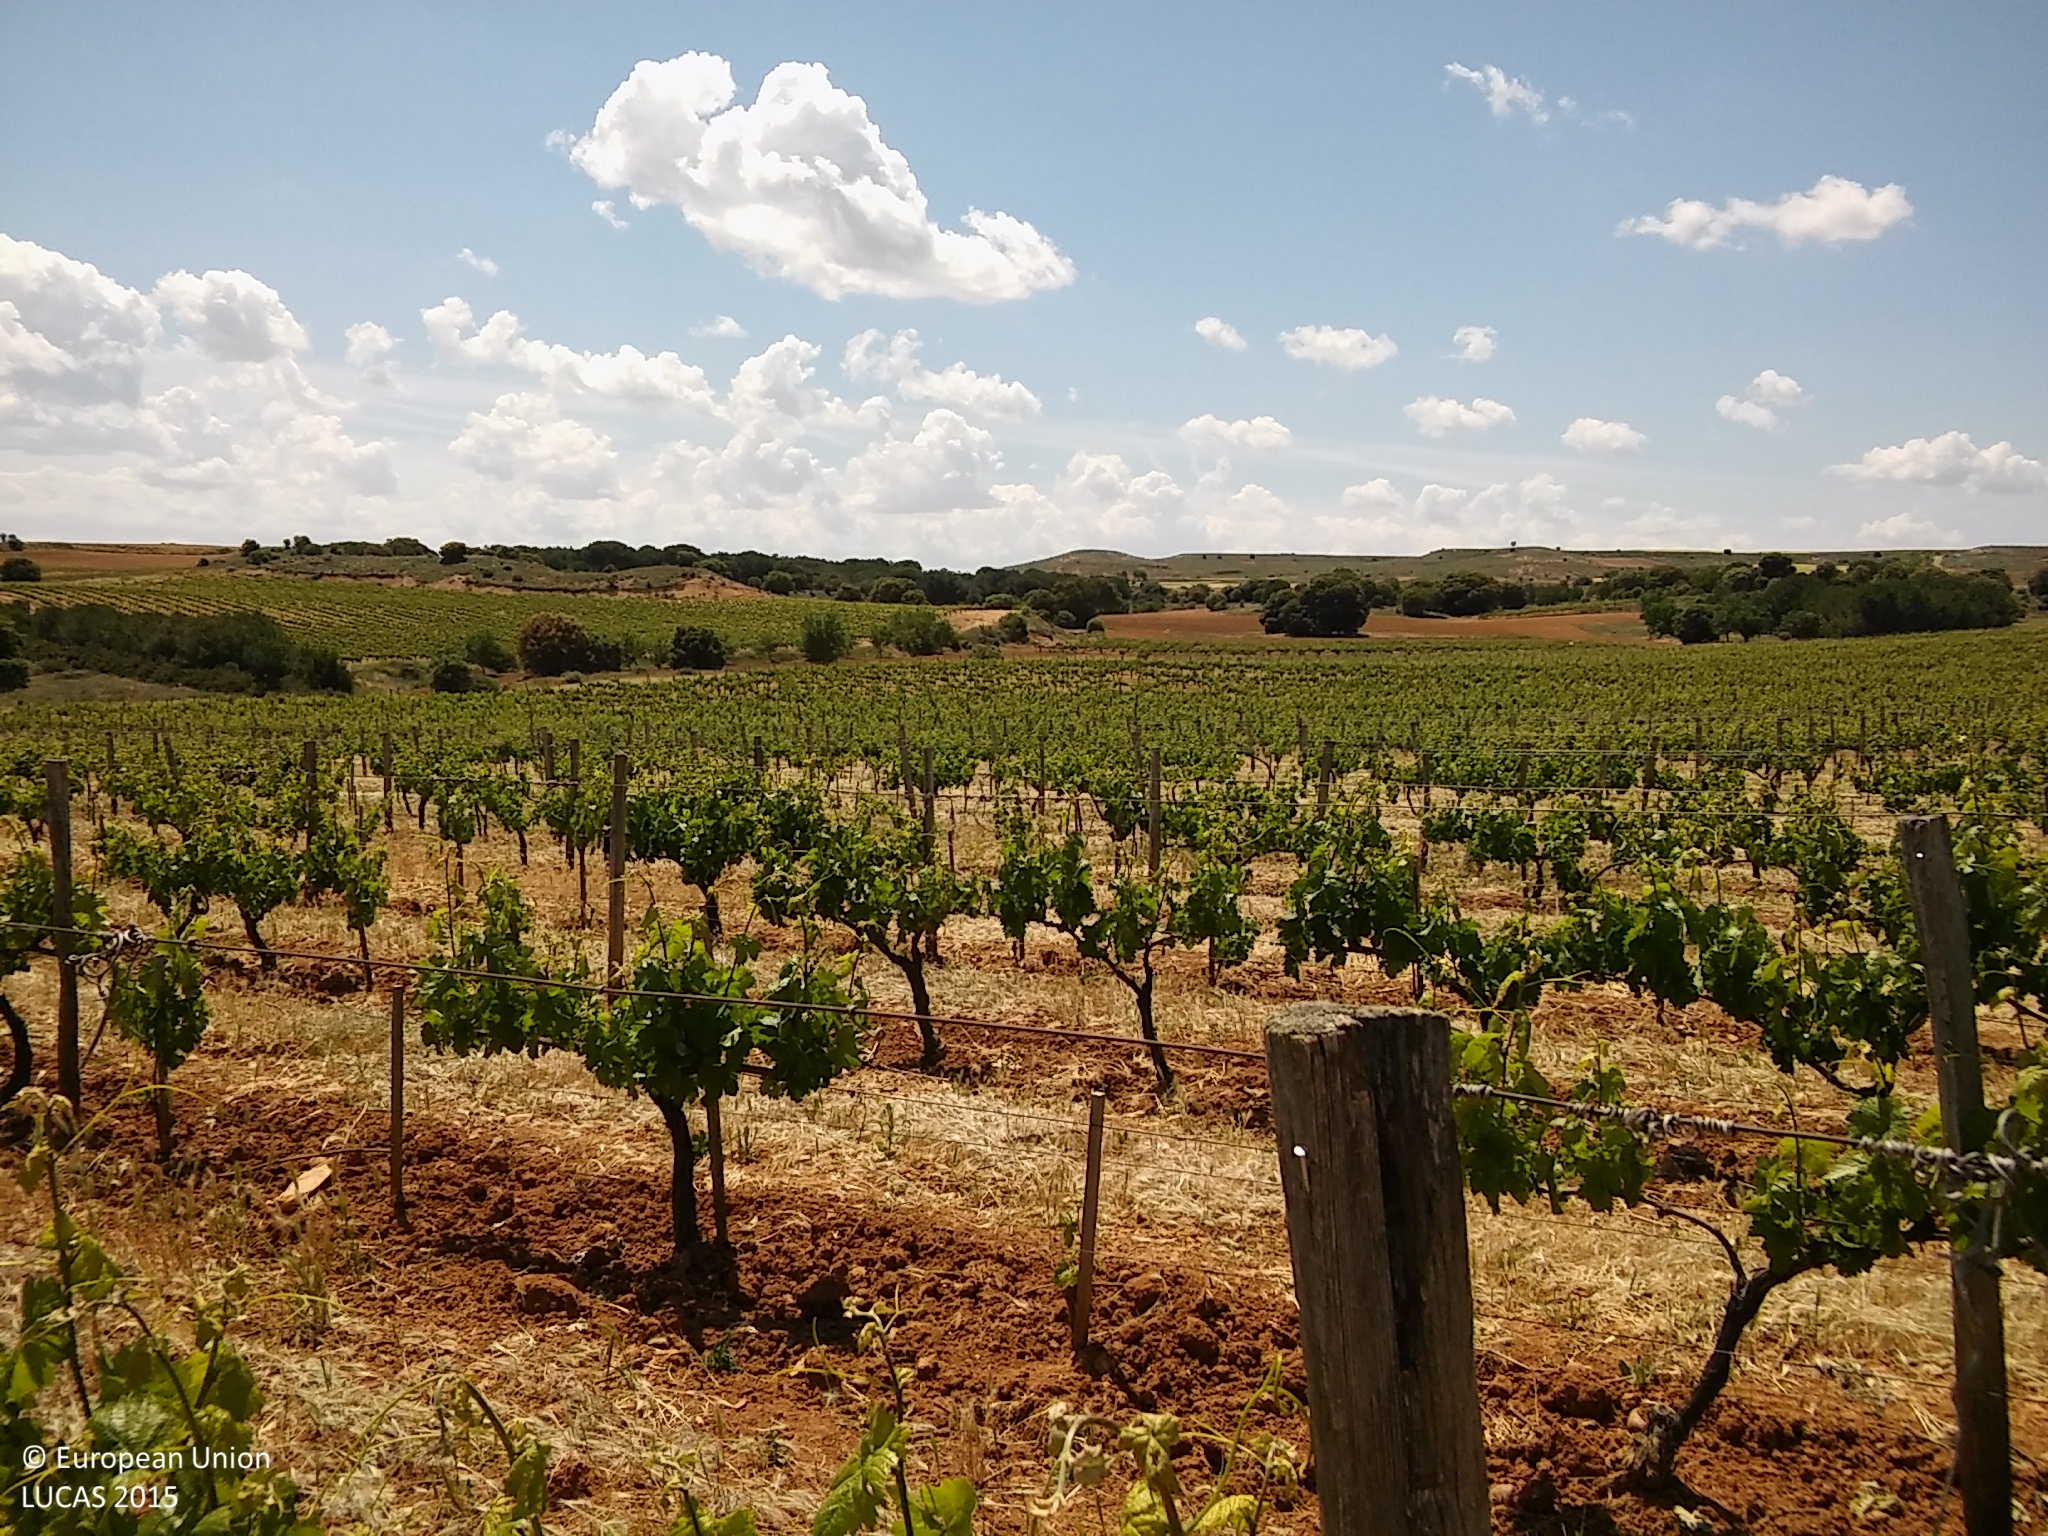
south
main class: Cropland
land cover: Vineyards
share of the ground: 10 - 25 %
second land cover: Other bare soil
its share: > 75 %
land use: Agriculture (excluding fallow land and kitchen gardens)
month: June
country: ES
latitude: 41.6412
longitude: -3.7274
